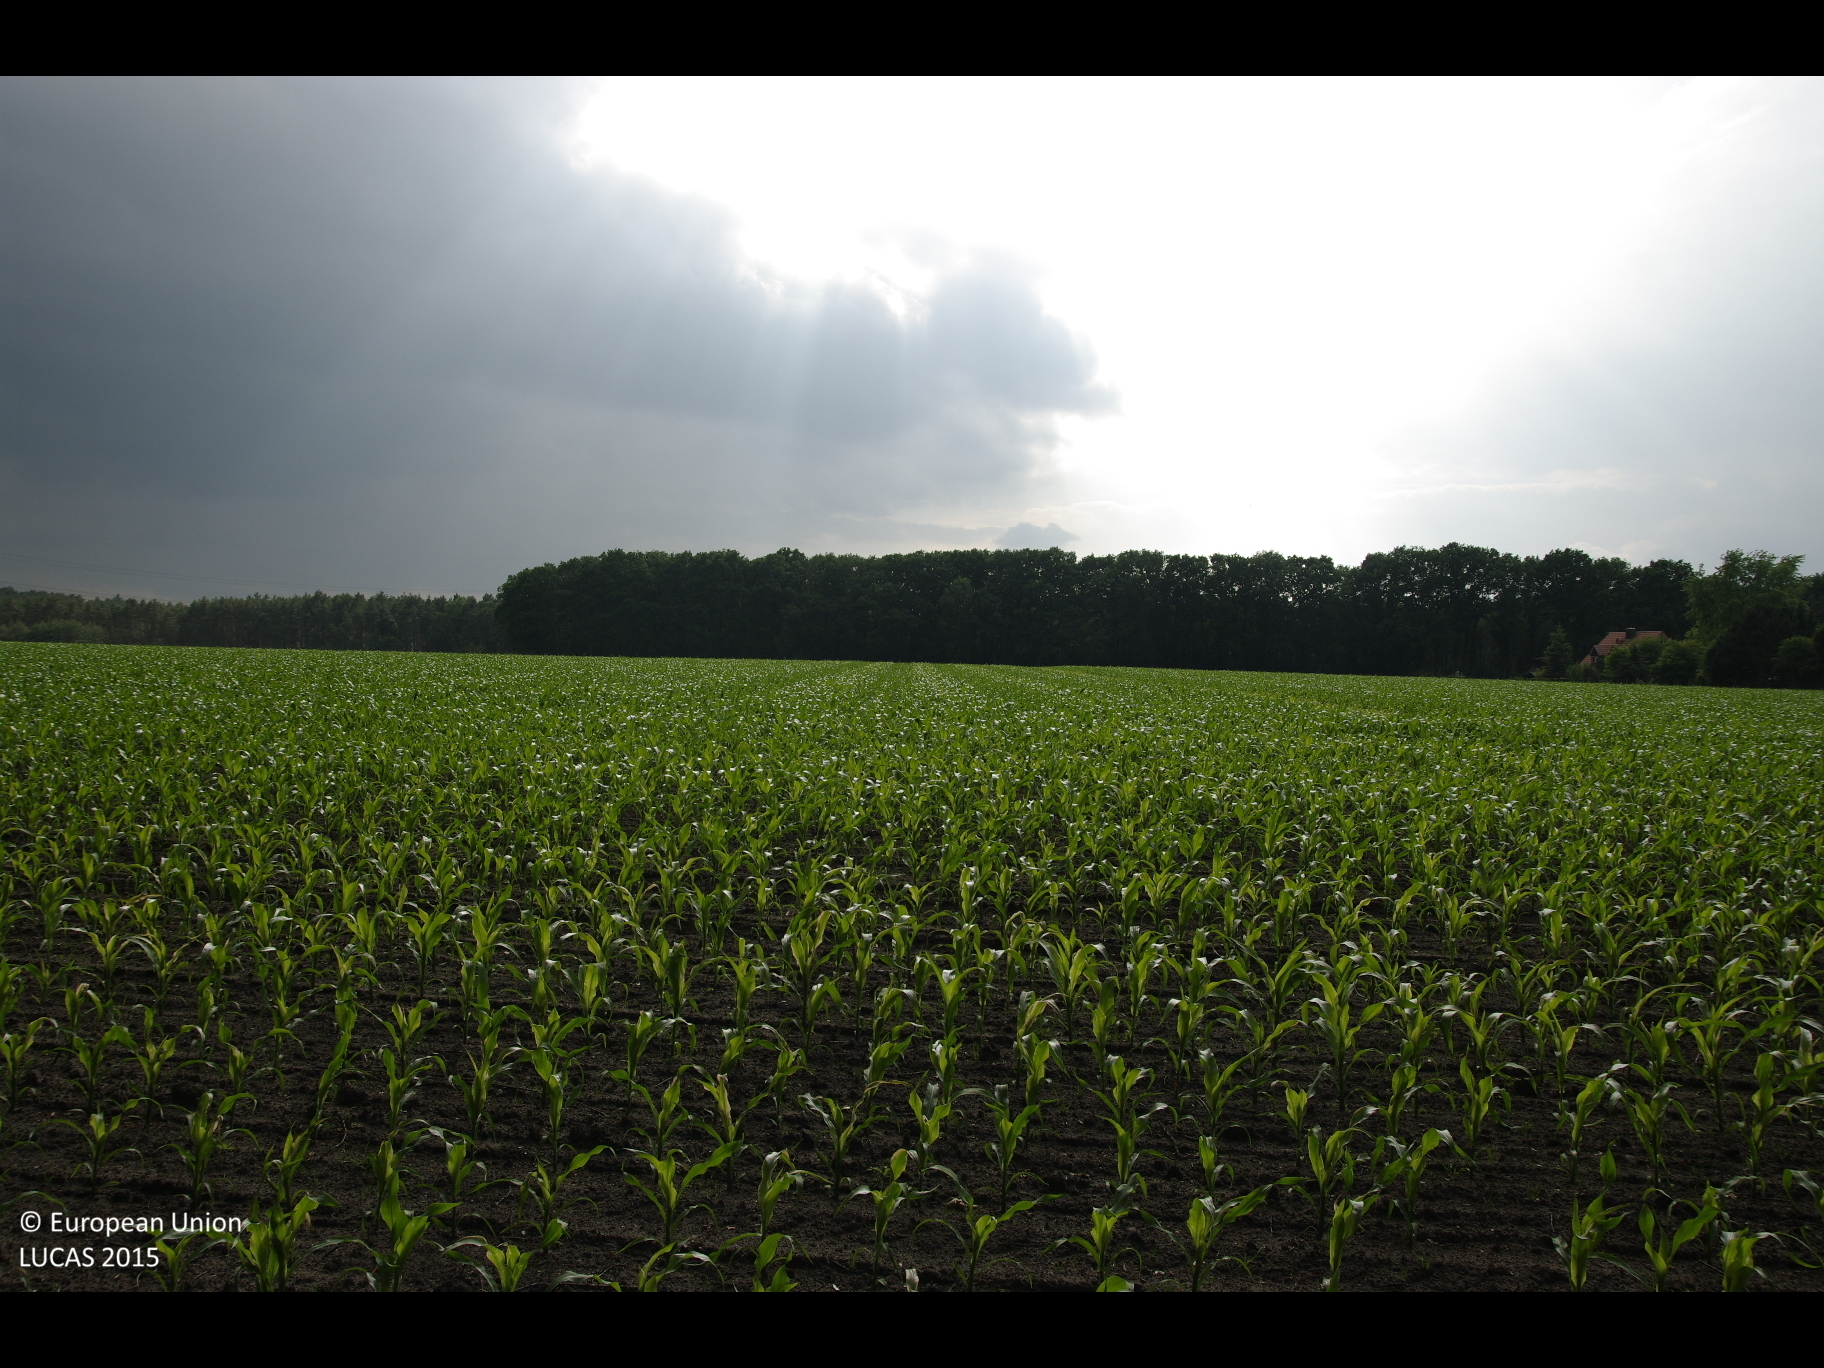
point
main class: Cropland
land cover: Maize
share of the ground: 25 - 50 %
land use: Agriculture (excluding fallow land and kitchen gardens)
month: June
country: DE
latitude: 53.2757
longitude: 10.3148
